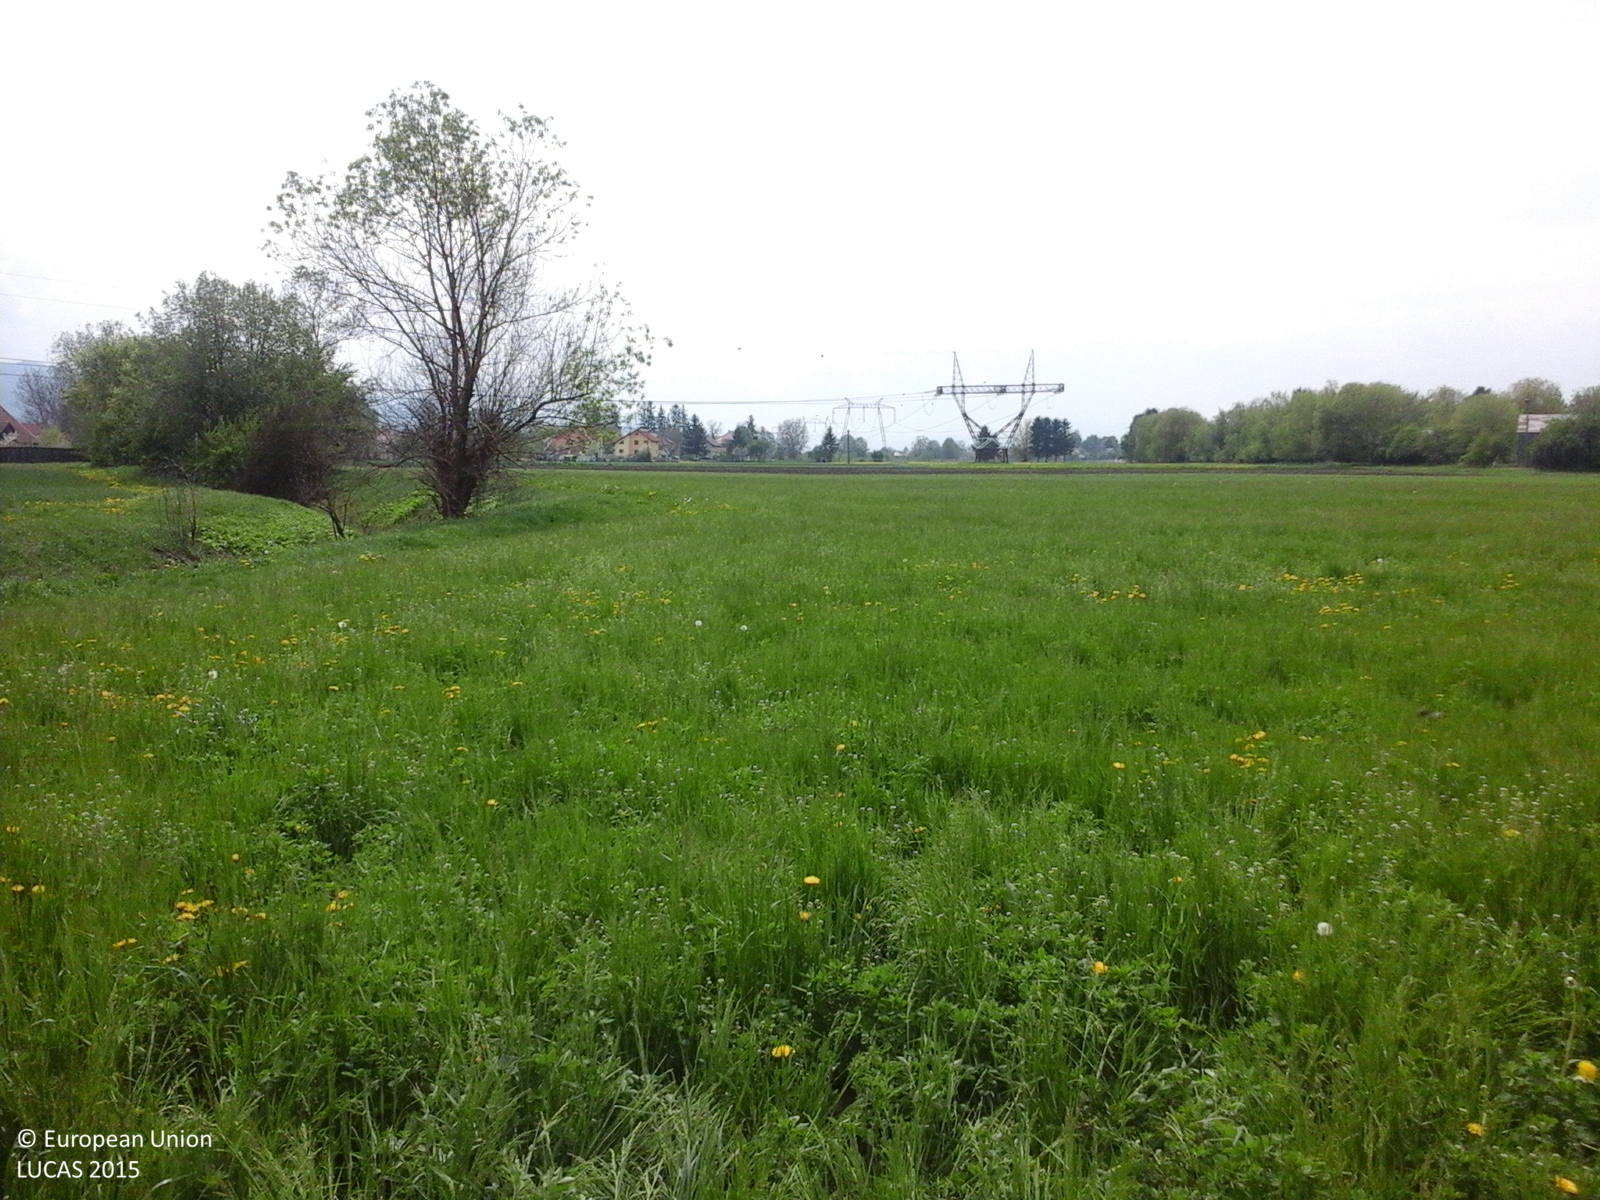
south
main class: Cropland
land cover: Other leguminous and mixtures for fodder
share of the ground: > 75 %
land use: Agriculture (excluding fallow land and kitchen gardens)
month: May
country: RO
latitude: 45.6995
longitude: 25.5541
